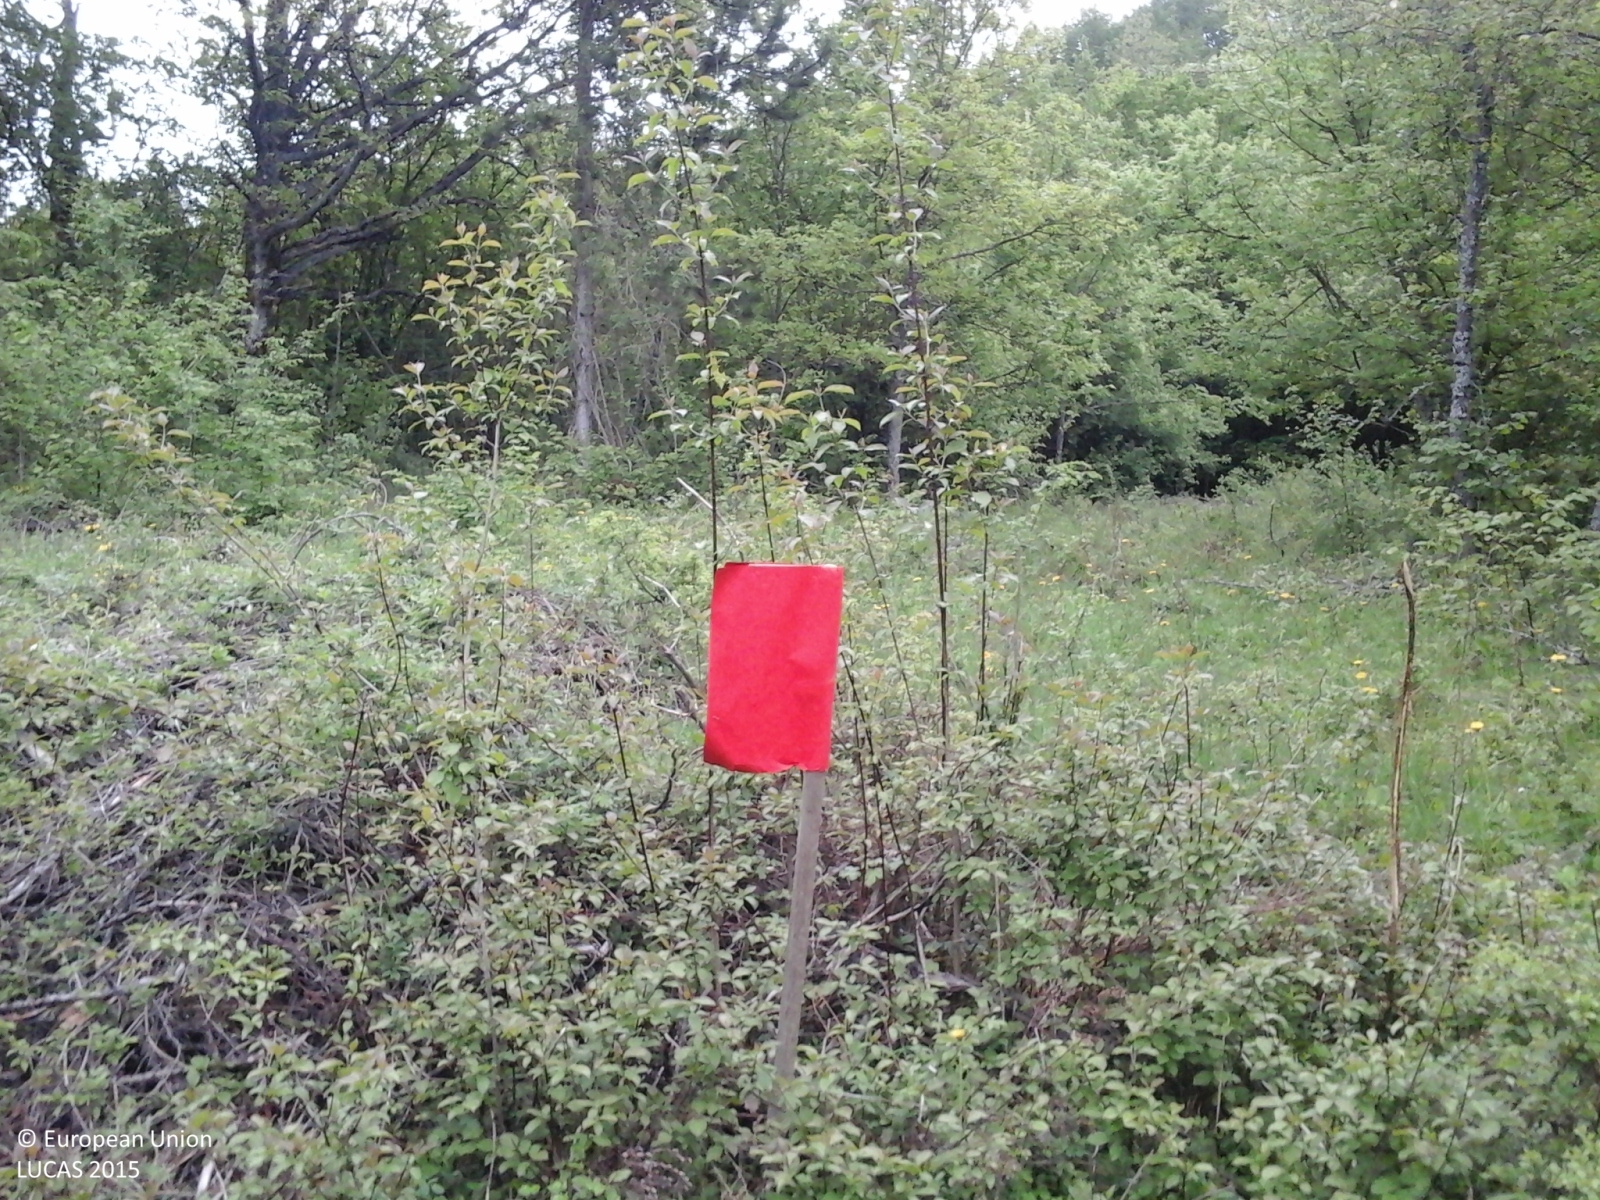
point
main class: Woodland
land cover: Broadleaved woodland
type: thermophilous deciduous forest
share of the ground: > 75 %
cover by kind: broadleaved forest trees 80 %, shrubs 15 %, herbaceous plants 5 %
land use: Forestry
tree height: > 5 m
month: May
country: IT
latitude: 44.6915
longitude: 9.4082
